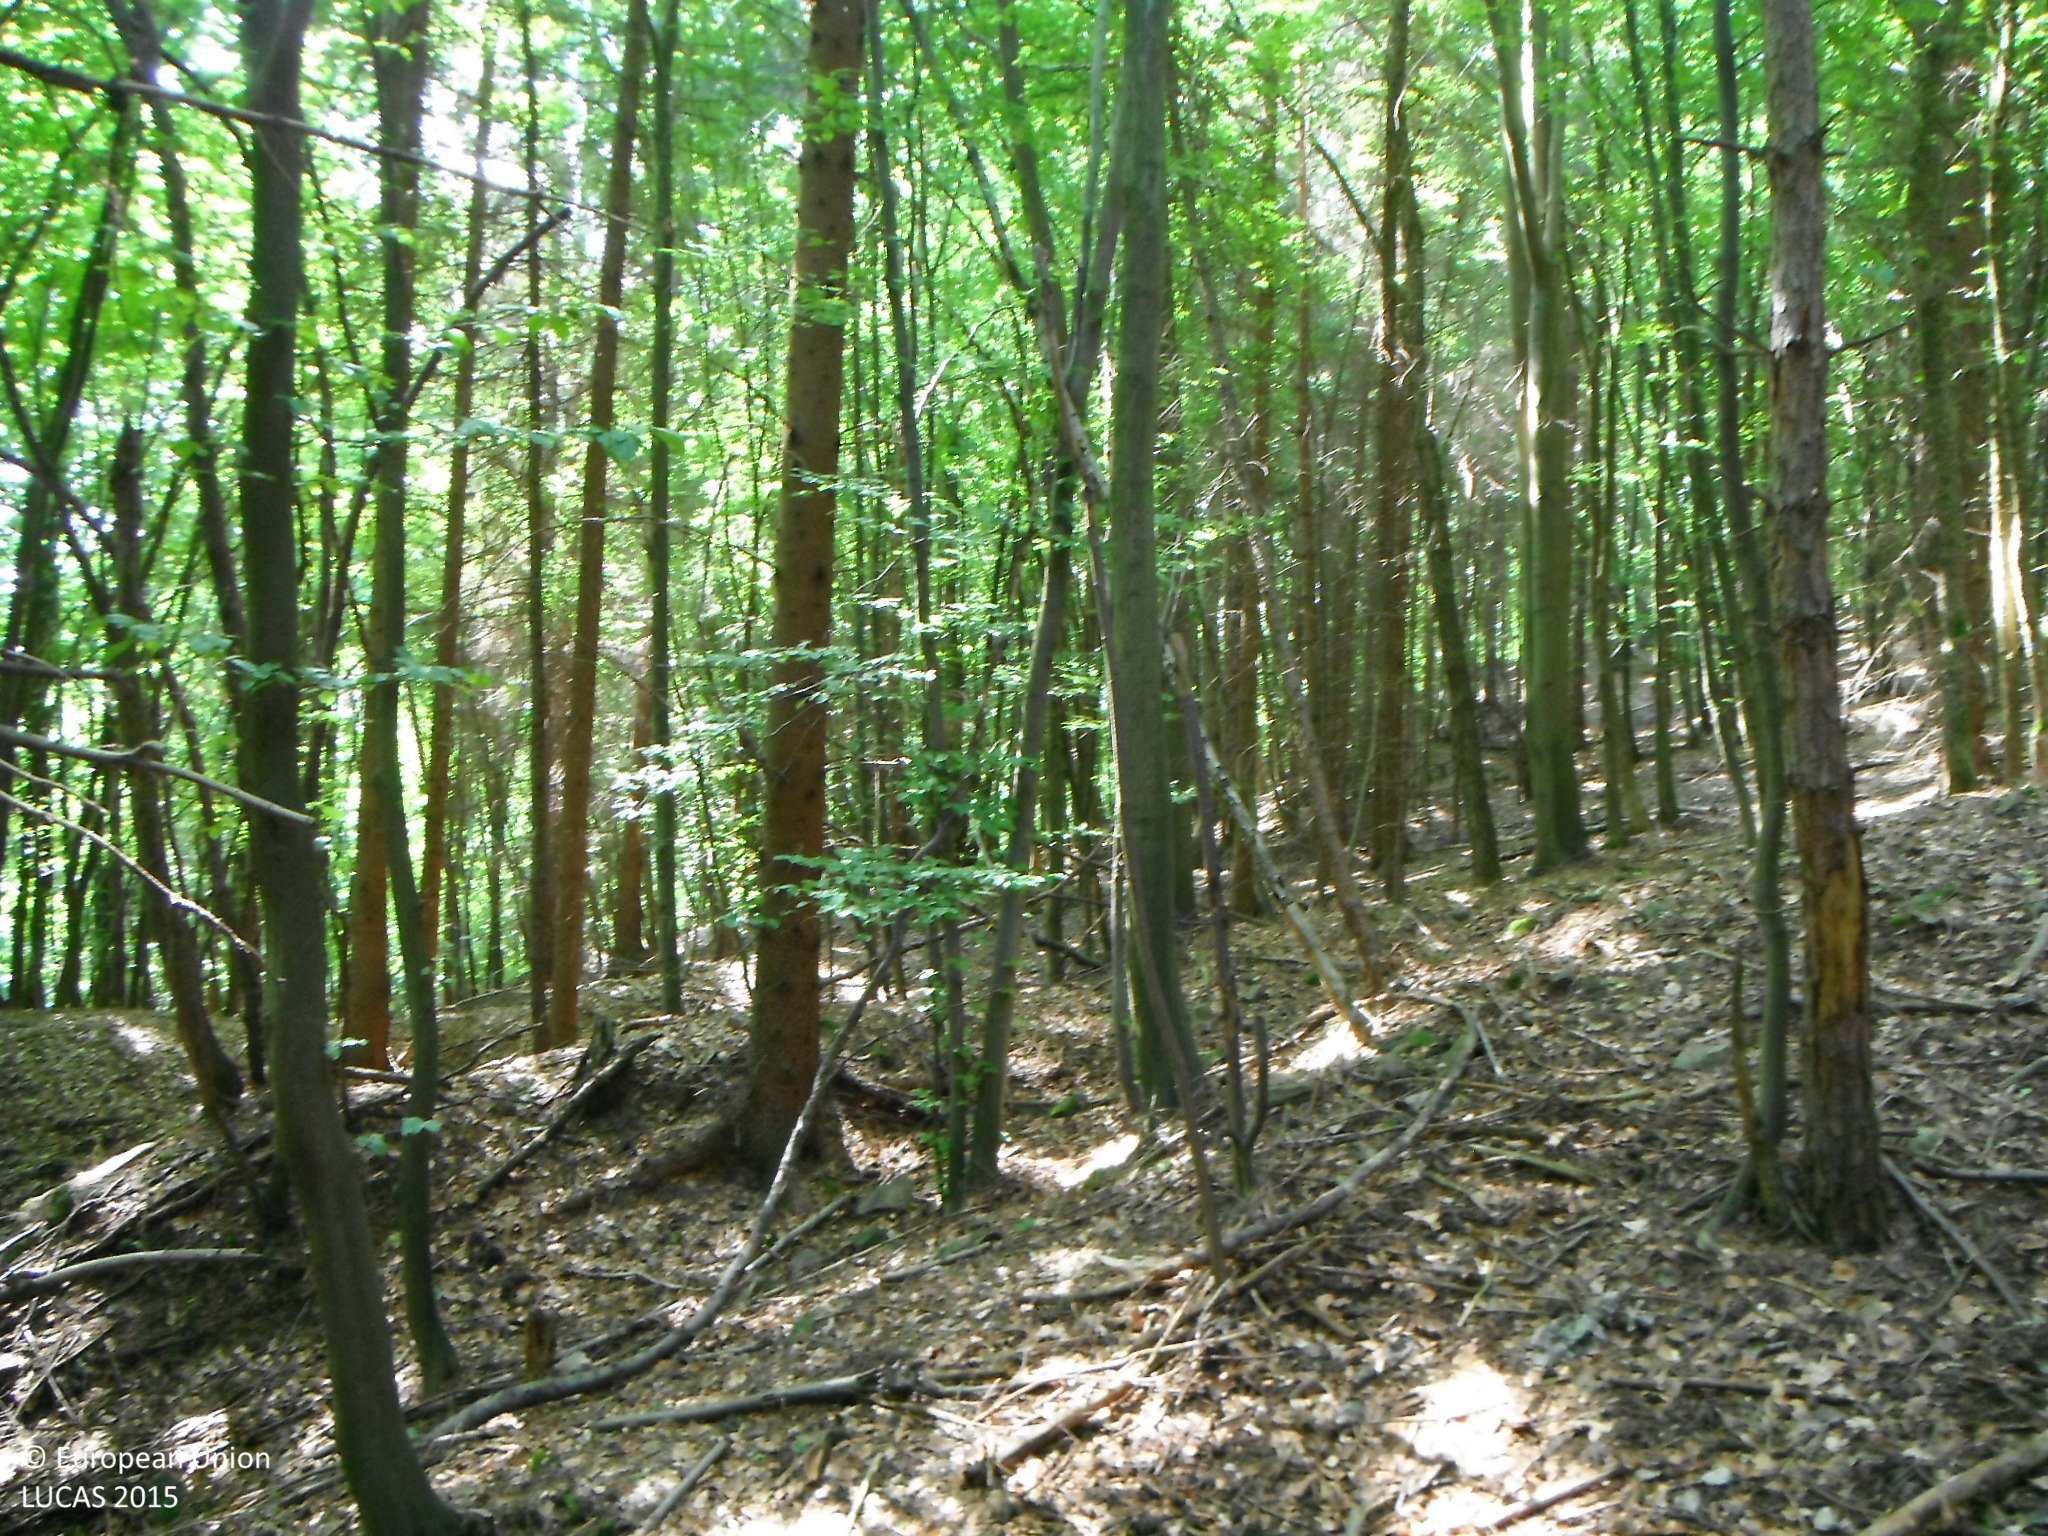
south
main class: Woodland
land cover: Spruce dominated mixed woodland
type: hemiboreal forest and nemoral coniferous forest and mixed broadleaved-coniferous forest
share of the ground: > 75 %
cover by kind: coniferous forest trees 60 %, broadleaved forest trees 40 %
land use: Forestry
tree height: > 5 m
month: July
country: SK
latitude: 49.2593
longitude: 18.6344
